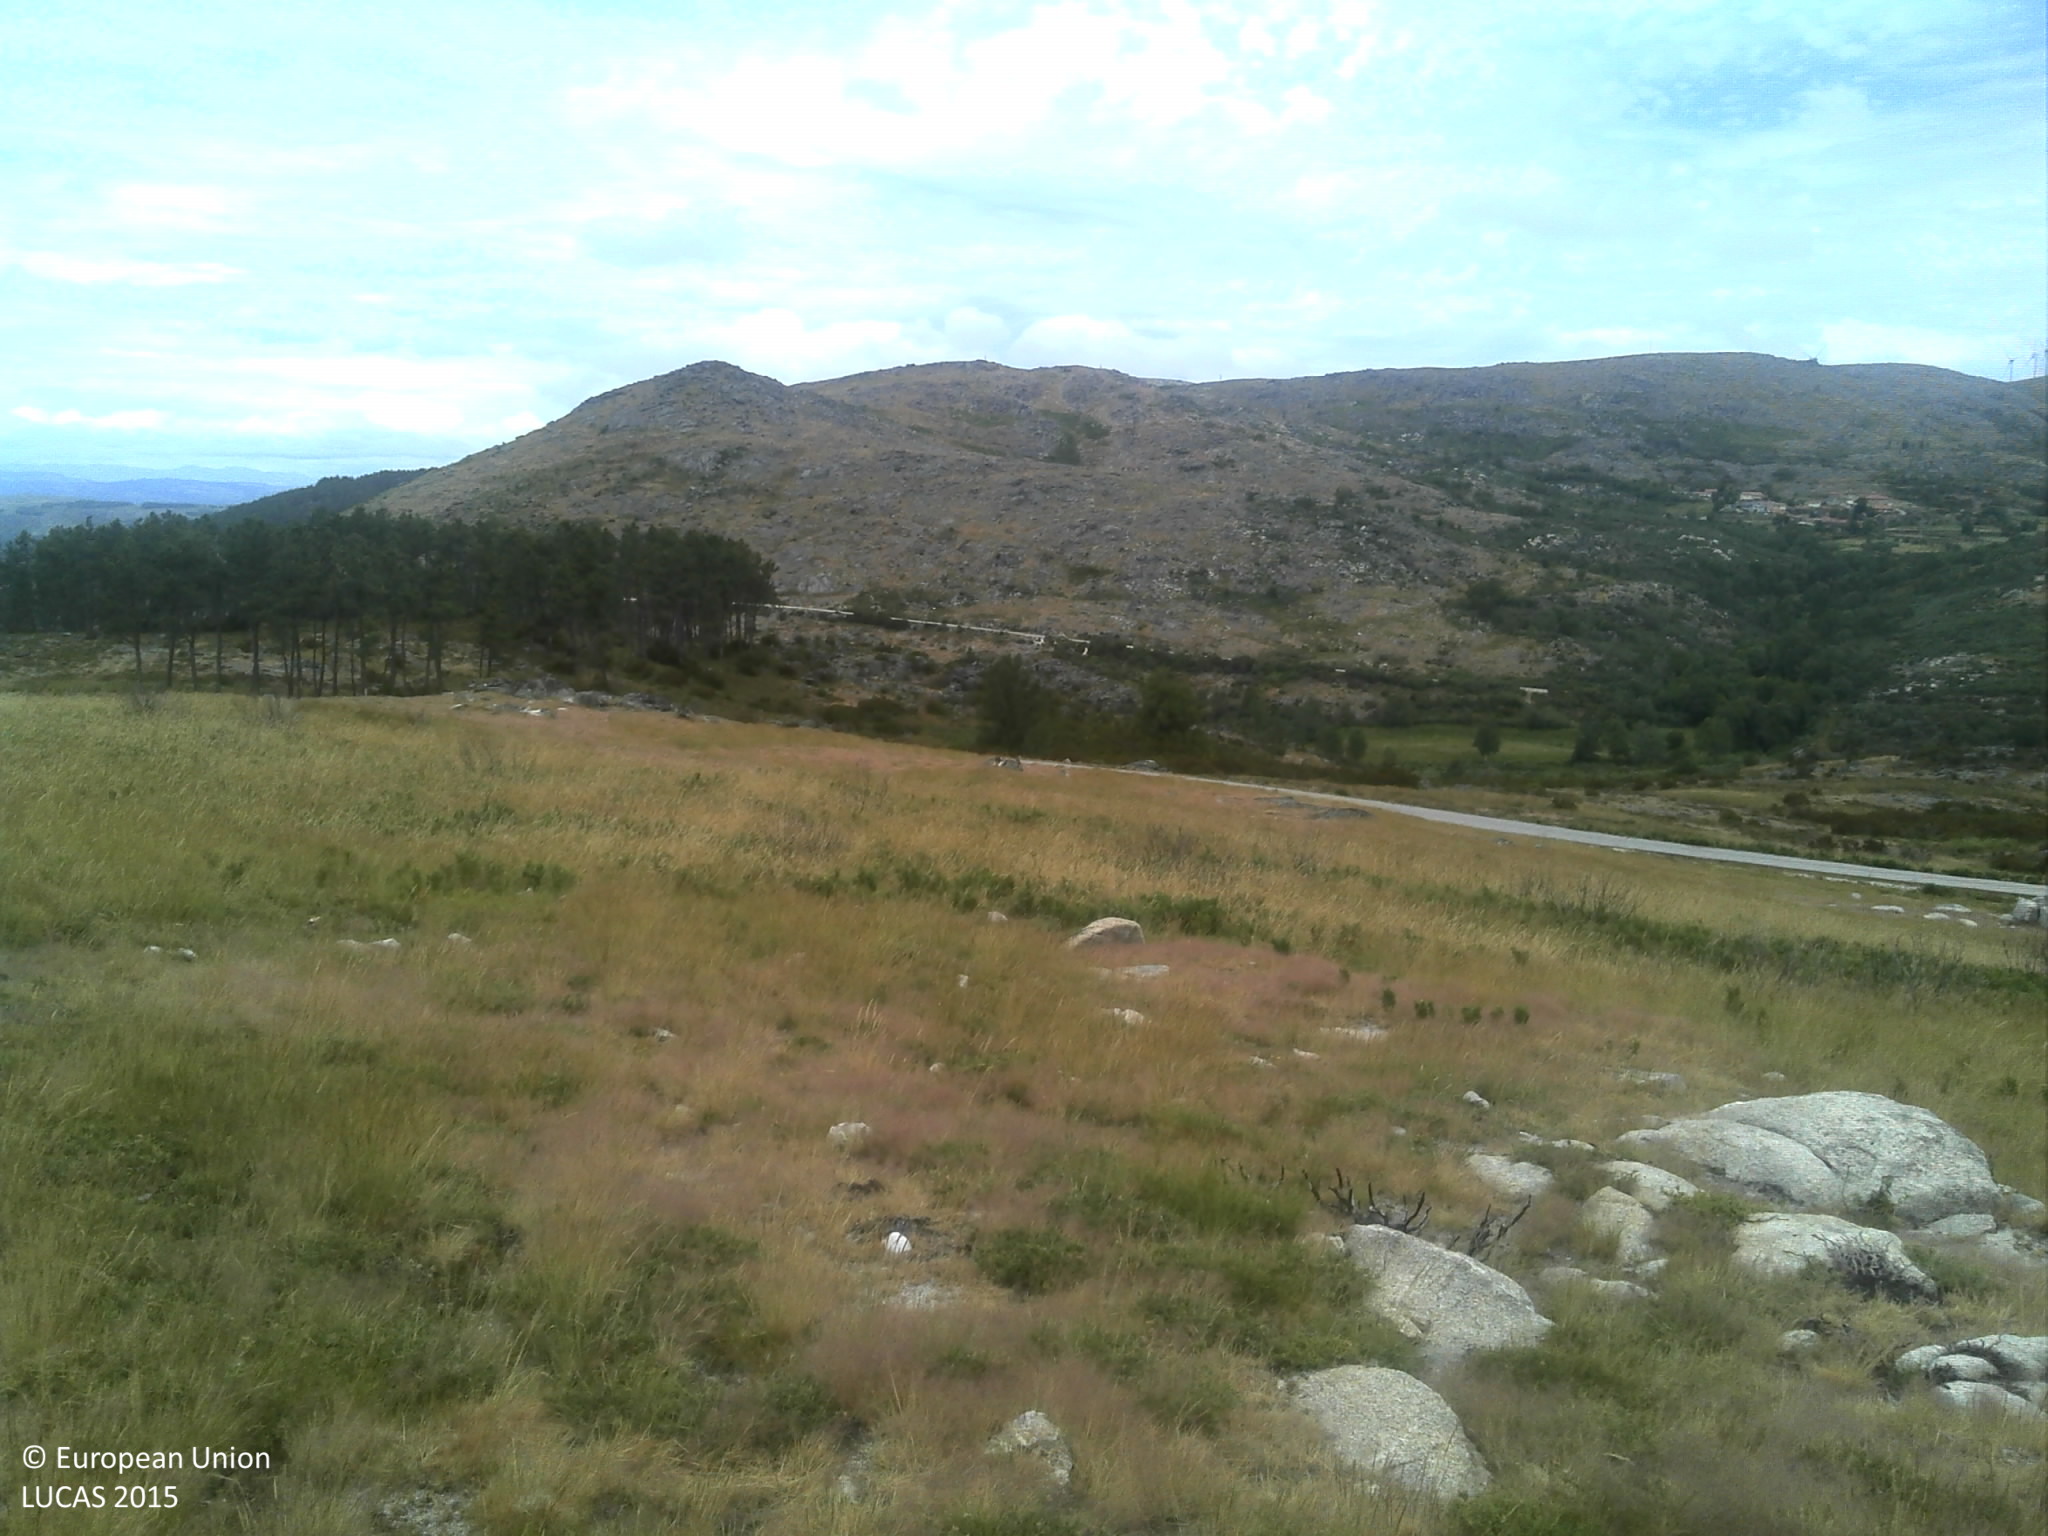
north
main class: Grassland
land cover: Grassland without tree/shrub cover
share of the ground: > 75 %
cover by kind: herbaceous plants 80 %, consolidated bare surface 10 %, shrubs 5 %, unconsolidated bare surface 5 %
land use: Agriculture (excluding fallow land and kitchen gardens)
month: July
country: PT
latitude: 41.3729
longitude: -7.8168
